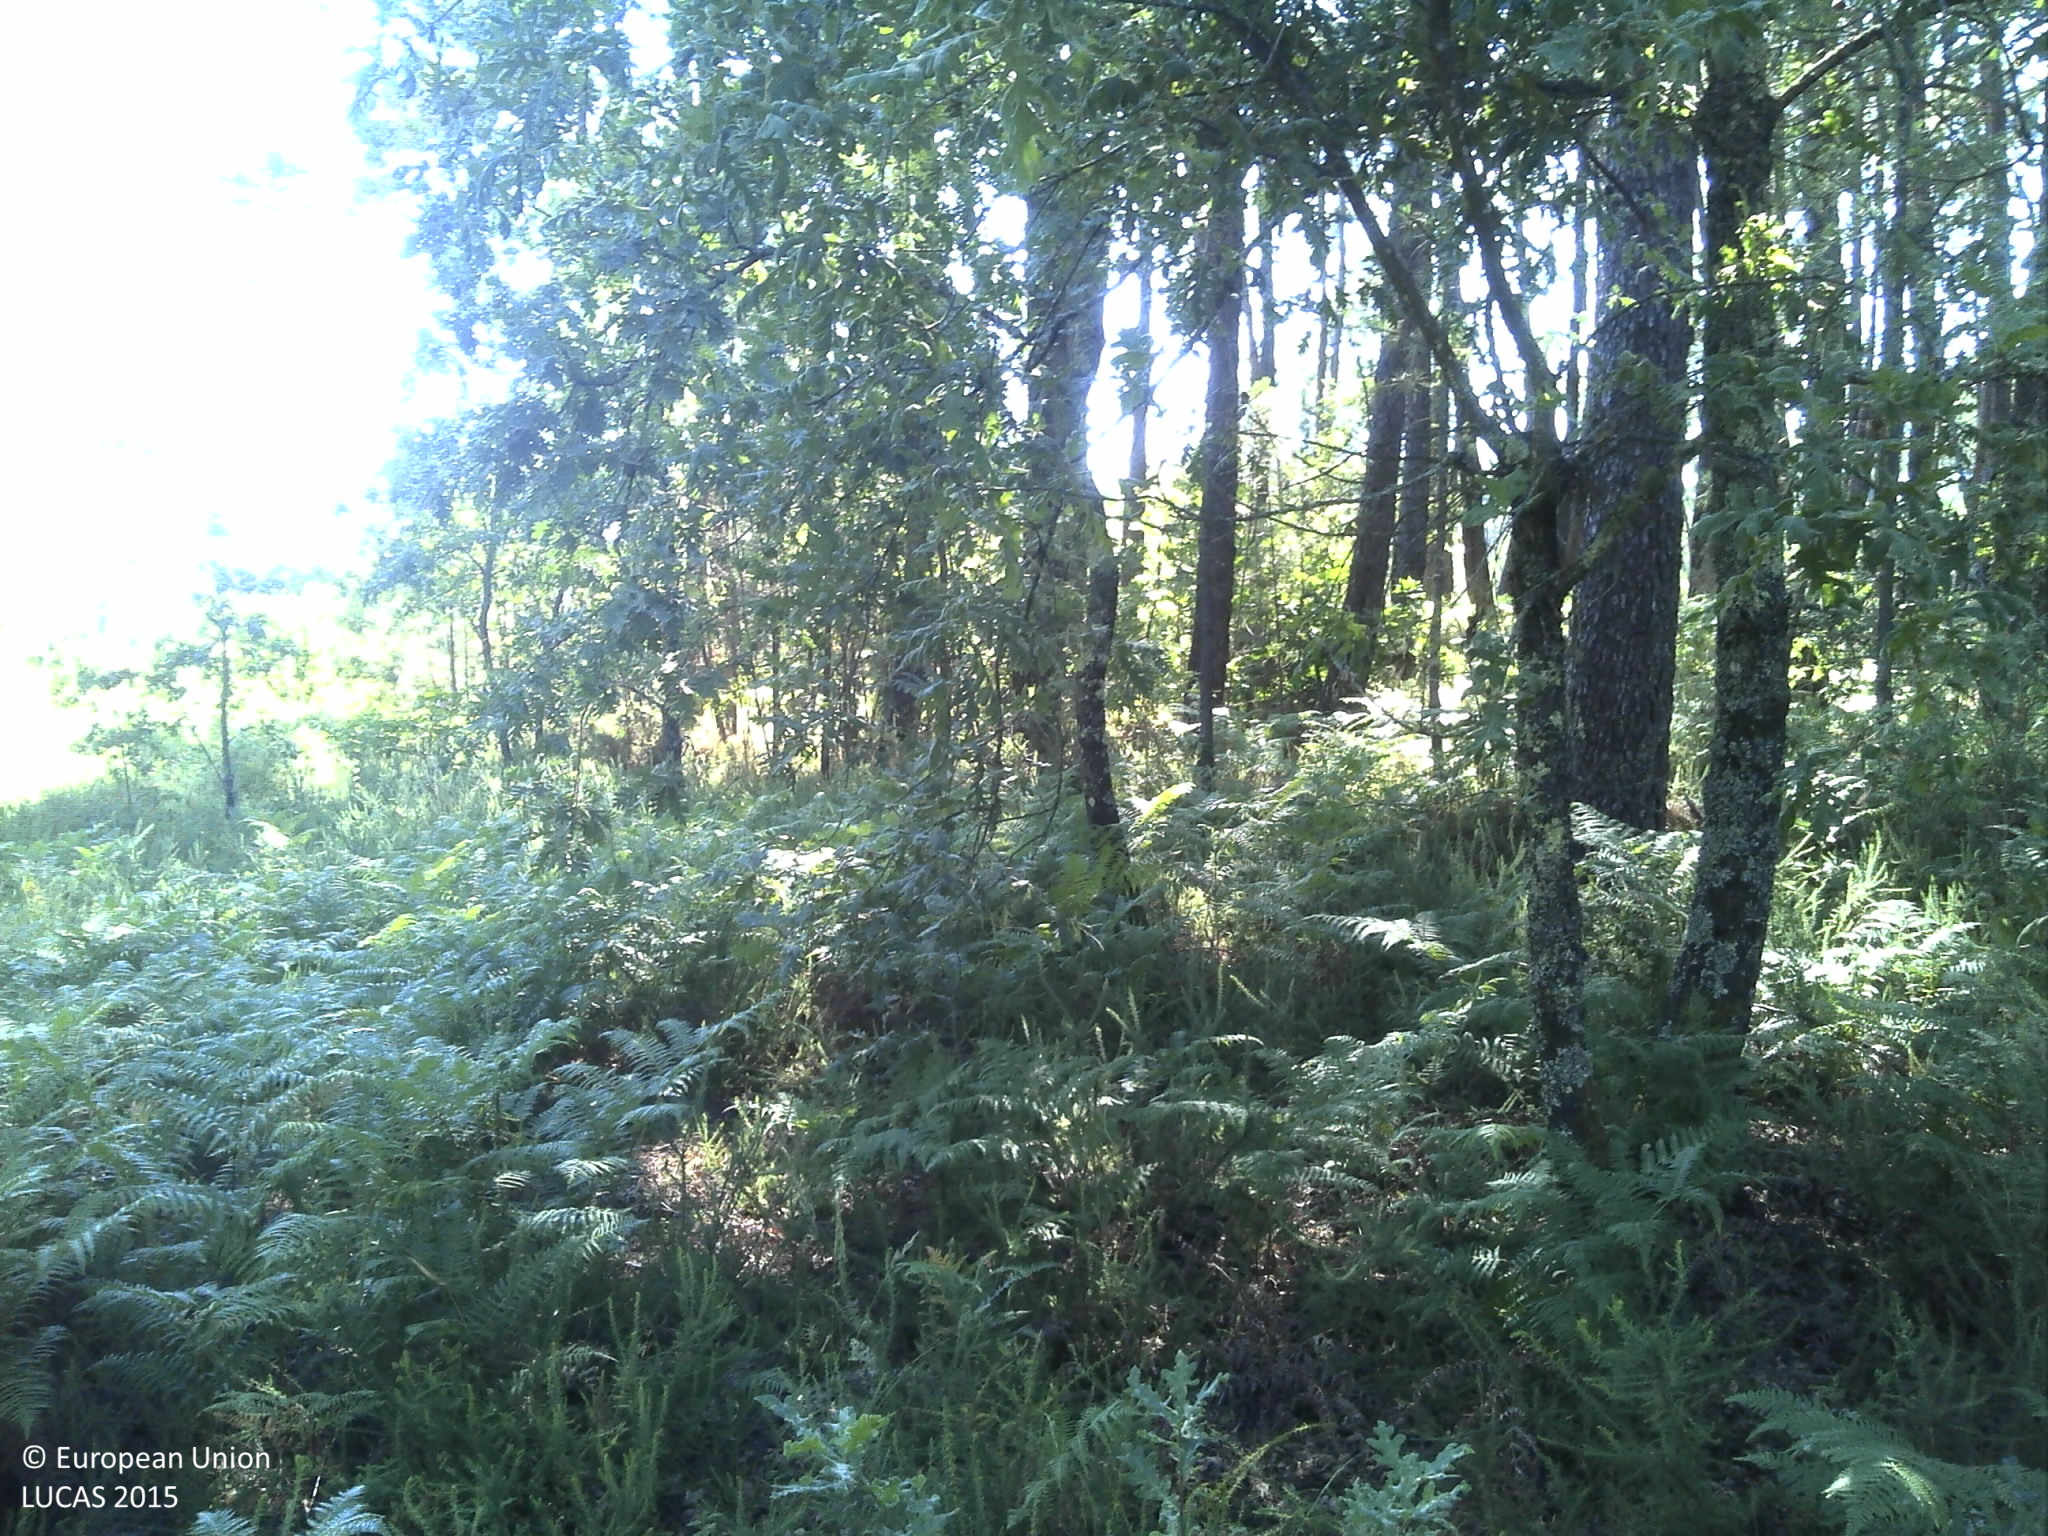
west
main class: Woodland
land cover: Broadleaved woodland
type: thermophilous deciduous forest
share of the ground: 50 - 75 %
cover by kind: broadleaved forest trees 70 %, unconsolidated bare surface 15 %, shrubs 10 %, coniferous forest trees 5 %
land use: Forestry
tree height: > 5 m
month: June
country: PT
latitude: 40.7046
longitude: -7.9388
